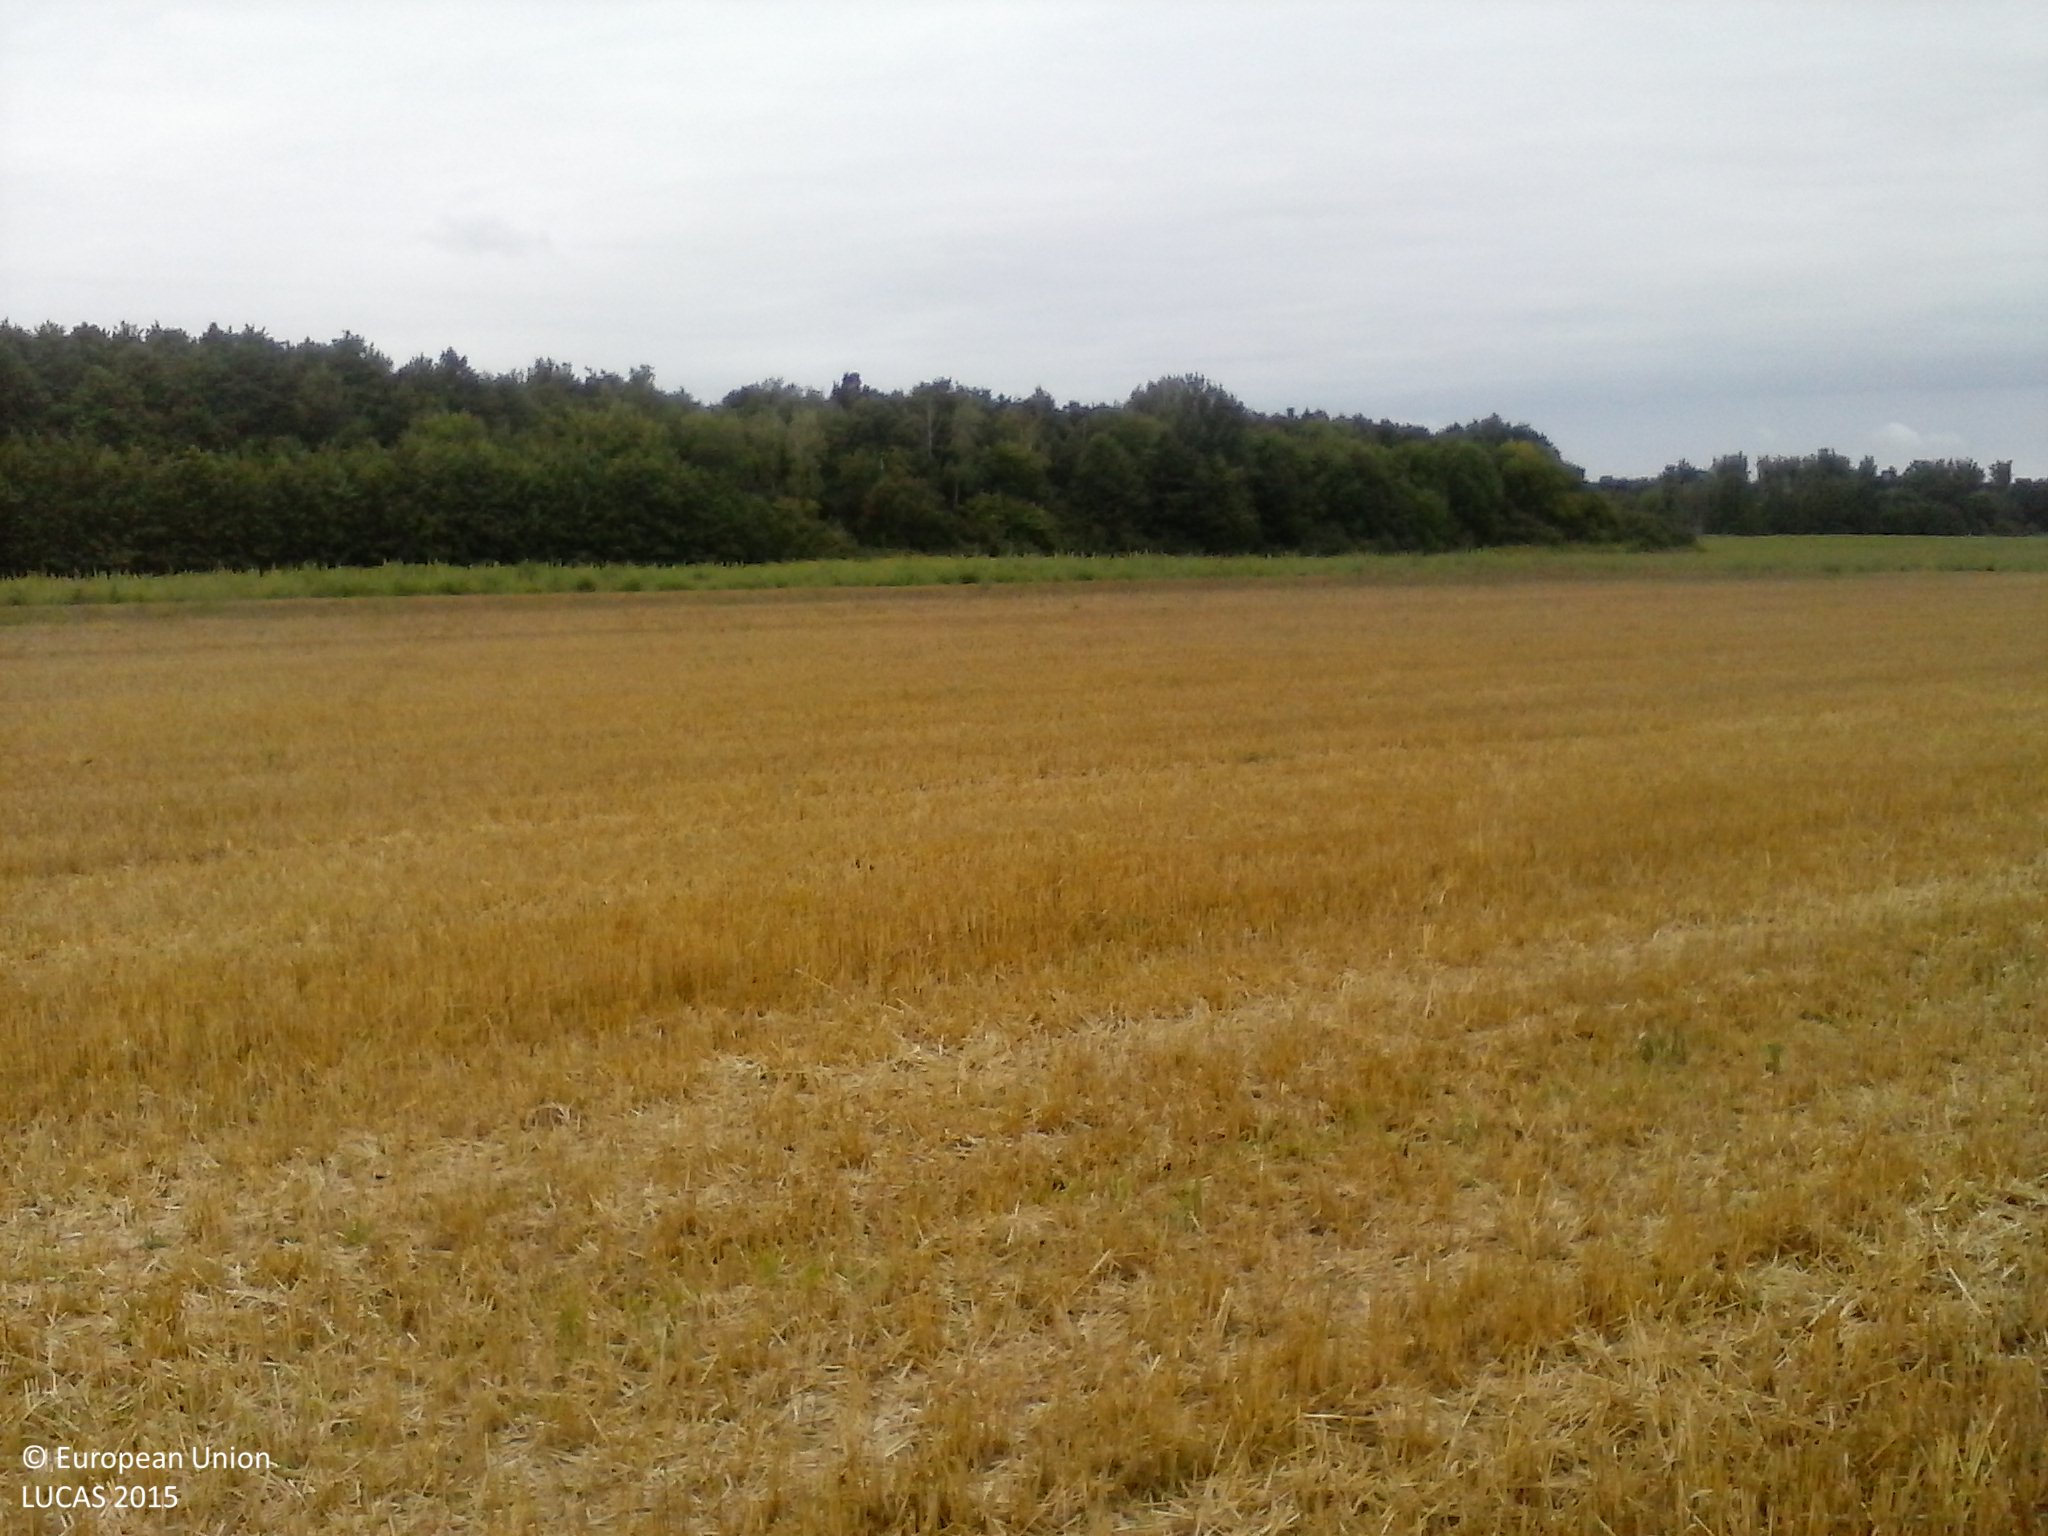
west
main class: Cropland
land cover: Common wheat
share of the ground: > 75 %
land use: Agriculture (excluding fallow land and kitchen gardens)
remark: Harvested field
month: July
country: HU
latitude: 46.0773
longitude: 17.6461
